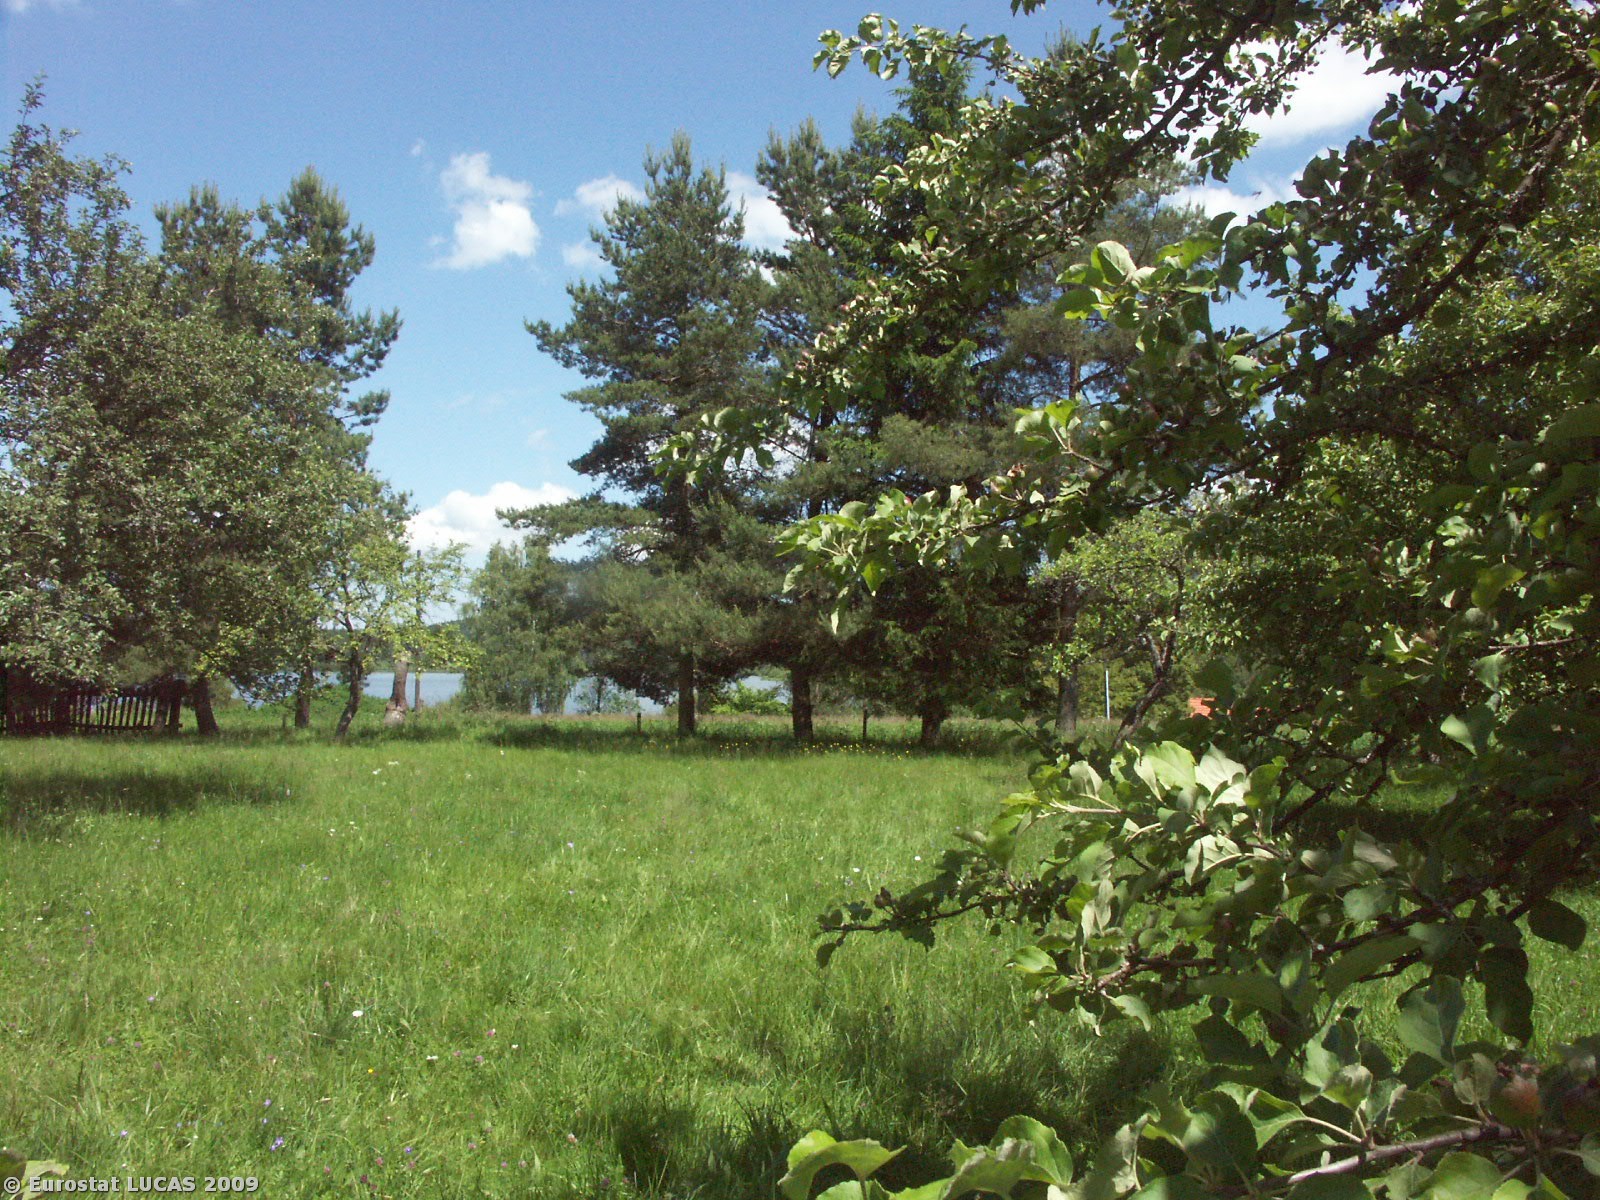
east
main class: Cropland
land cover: Apple fruit
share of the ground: 25 - 50 %
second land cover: Grassland with sparse tree/shrub cover
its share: > 75 %
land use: Kitchen garden
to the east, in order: Apple fruit; Grassland with sparse tree/shrub cover; Fences; Coniferous woodland; Potatoes; Spontaneously vegetated surfaces; Potatoes; Grassland without tree/shrub cover; Electric lines; Broadleaved woodland; Rock outcrops; Rivers and streams; Rock outcrops; Broadleaved woodland; Artificial constructions in urban areas; Fences; Paved roads, cycling and walking lanes; Grassland without tree/shrub cover; Broadleaved woodland; Inland running water; Artificial constructions
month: June
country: CZ
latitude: 48.7780
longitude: 14.0965
